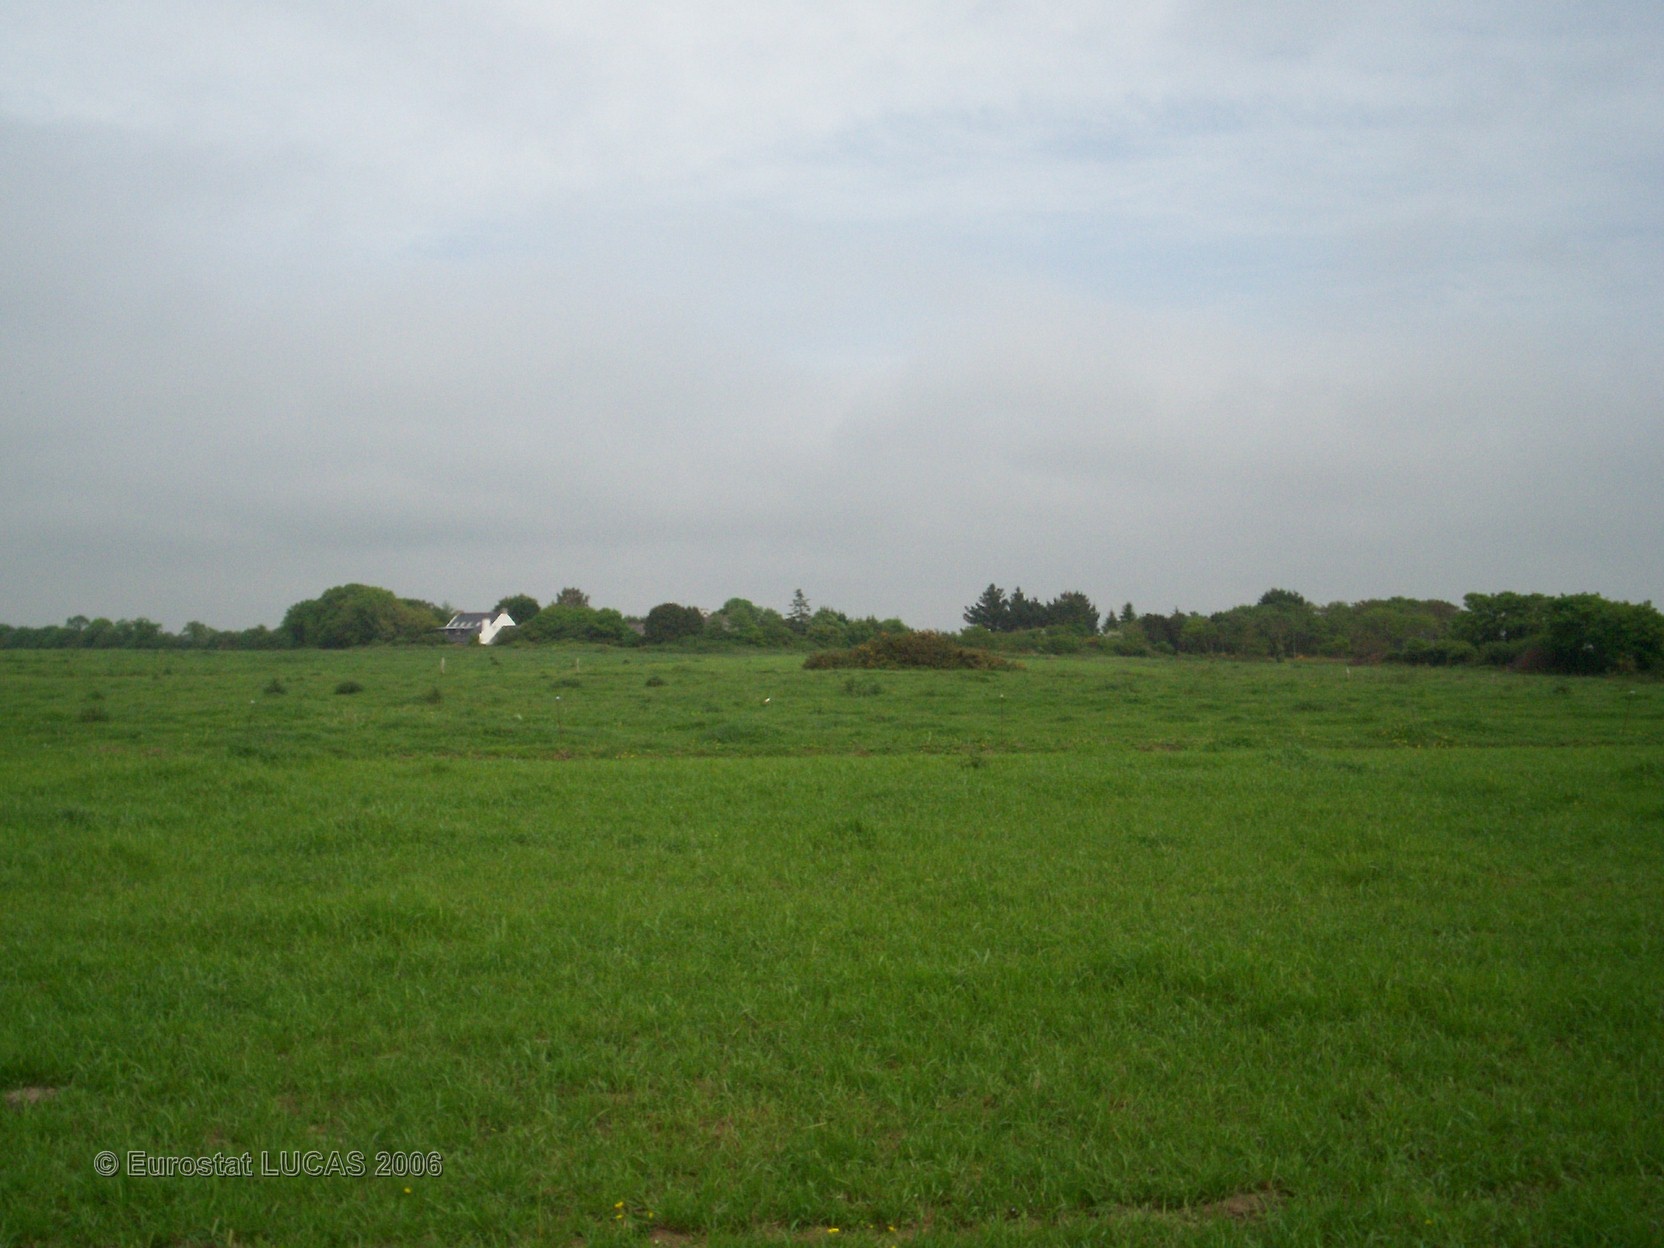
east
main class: Grassland
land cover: Grassland without tree/shrub cover
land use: Agriculture (excluding fallow land and kitchen gardens)
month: May
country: FR
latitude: 47.8184
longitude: -3.8522
